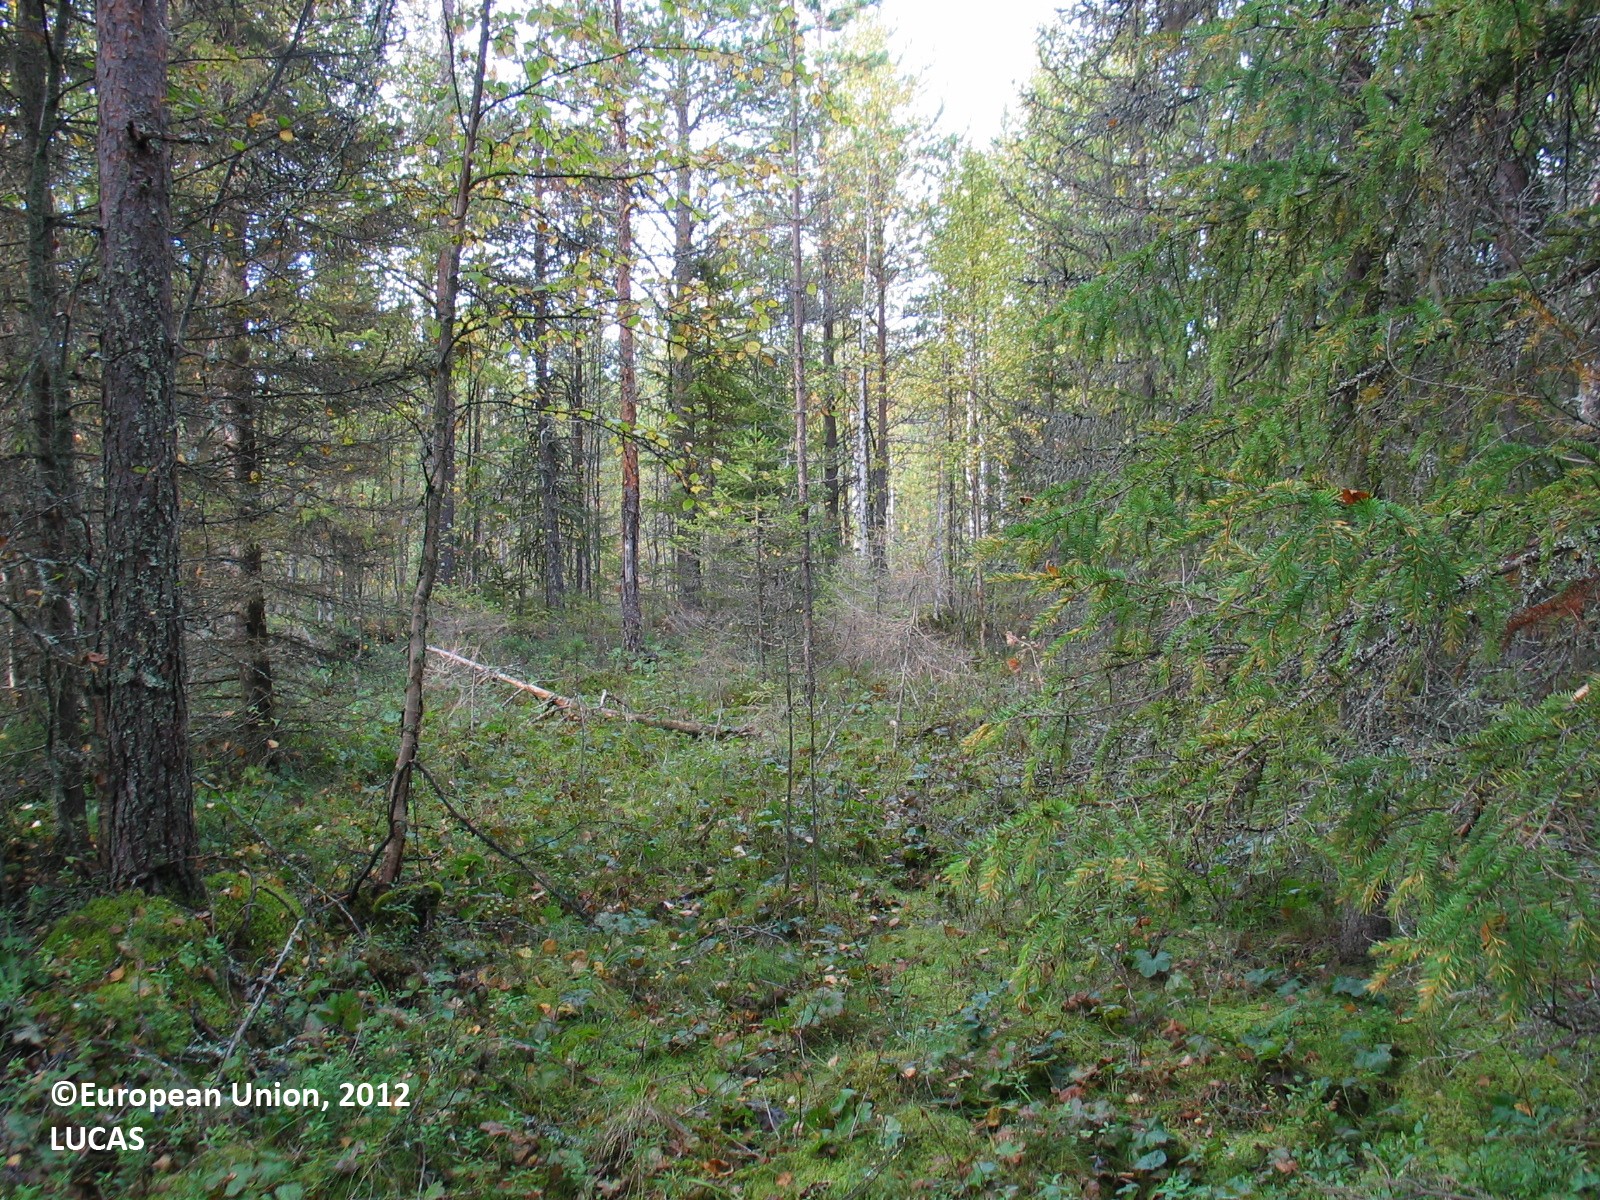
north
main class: Woodland
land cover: Other mixed woodland
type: mire and swamp forests
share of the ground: 25 - 50 %
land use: Forestry
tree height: > 5 m
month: September
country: FI
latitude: 65.6156
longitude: 25.8209
